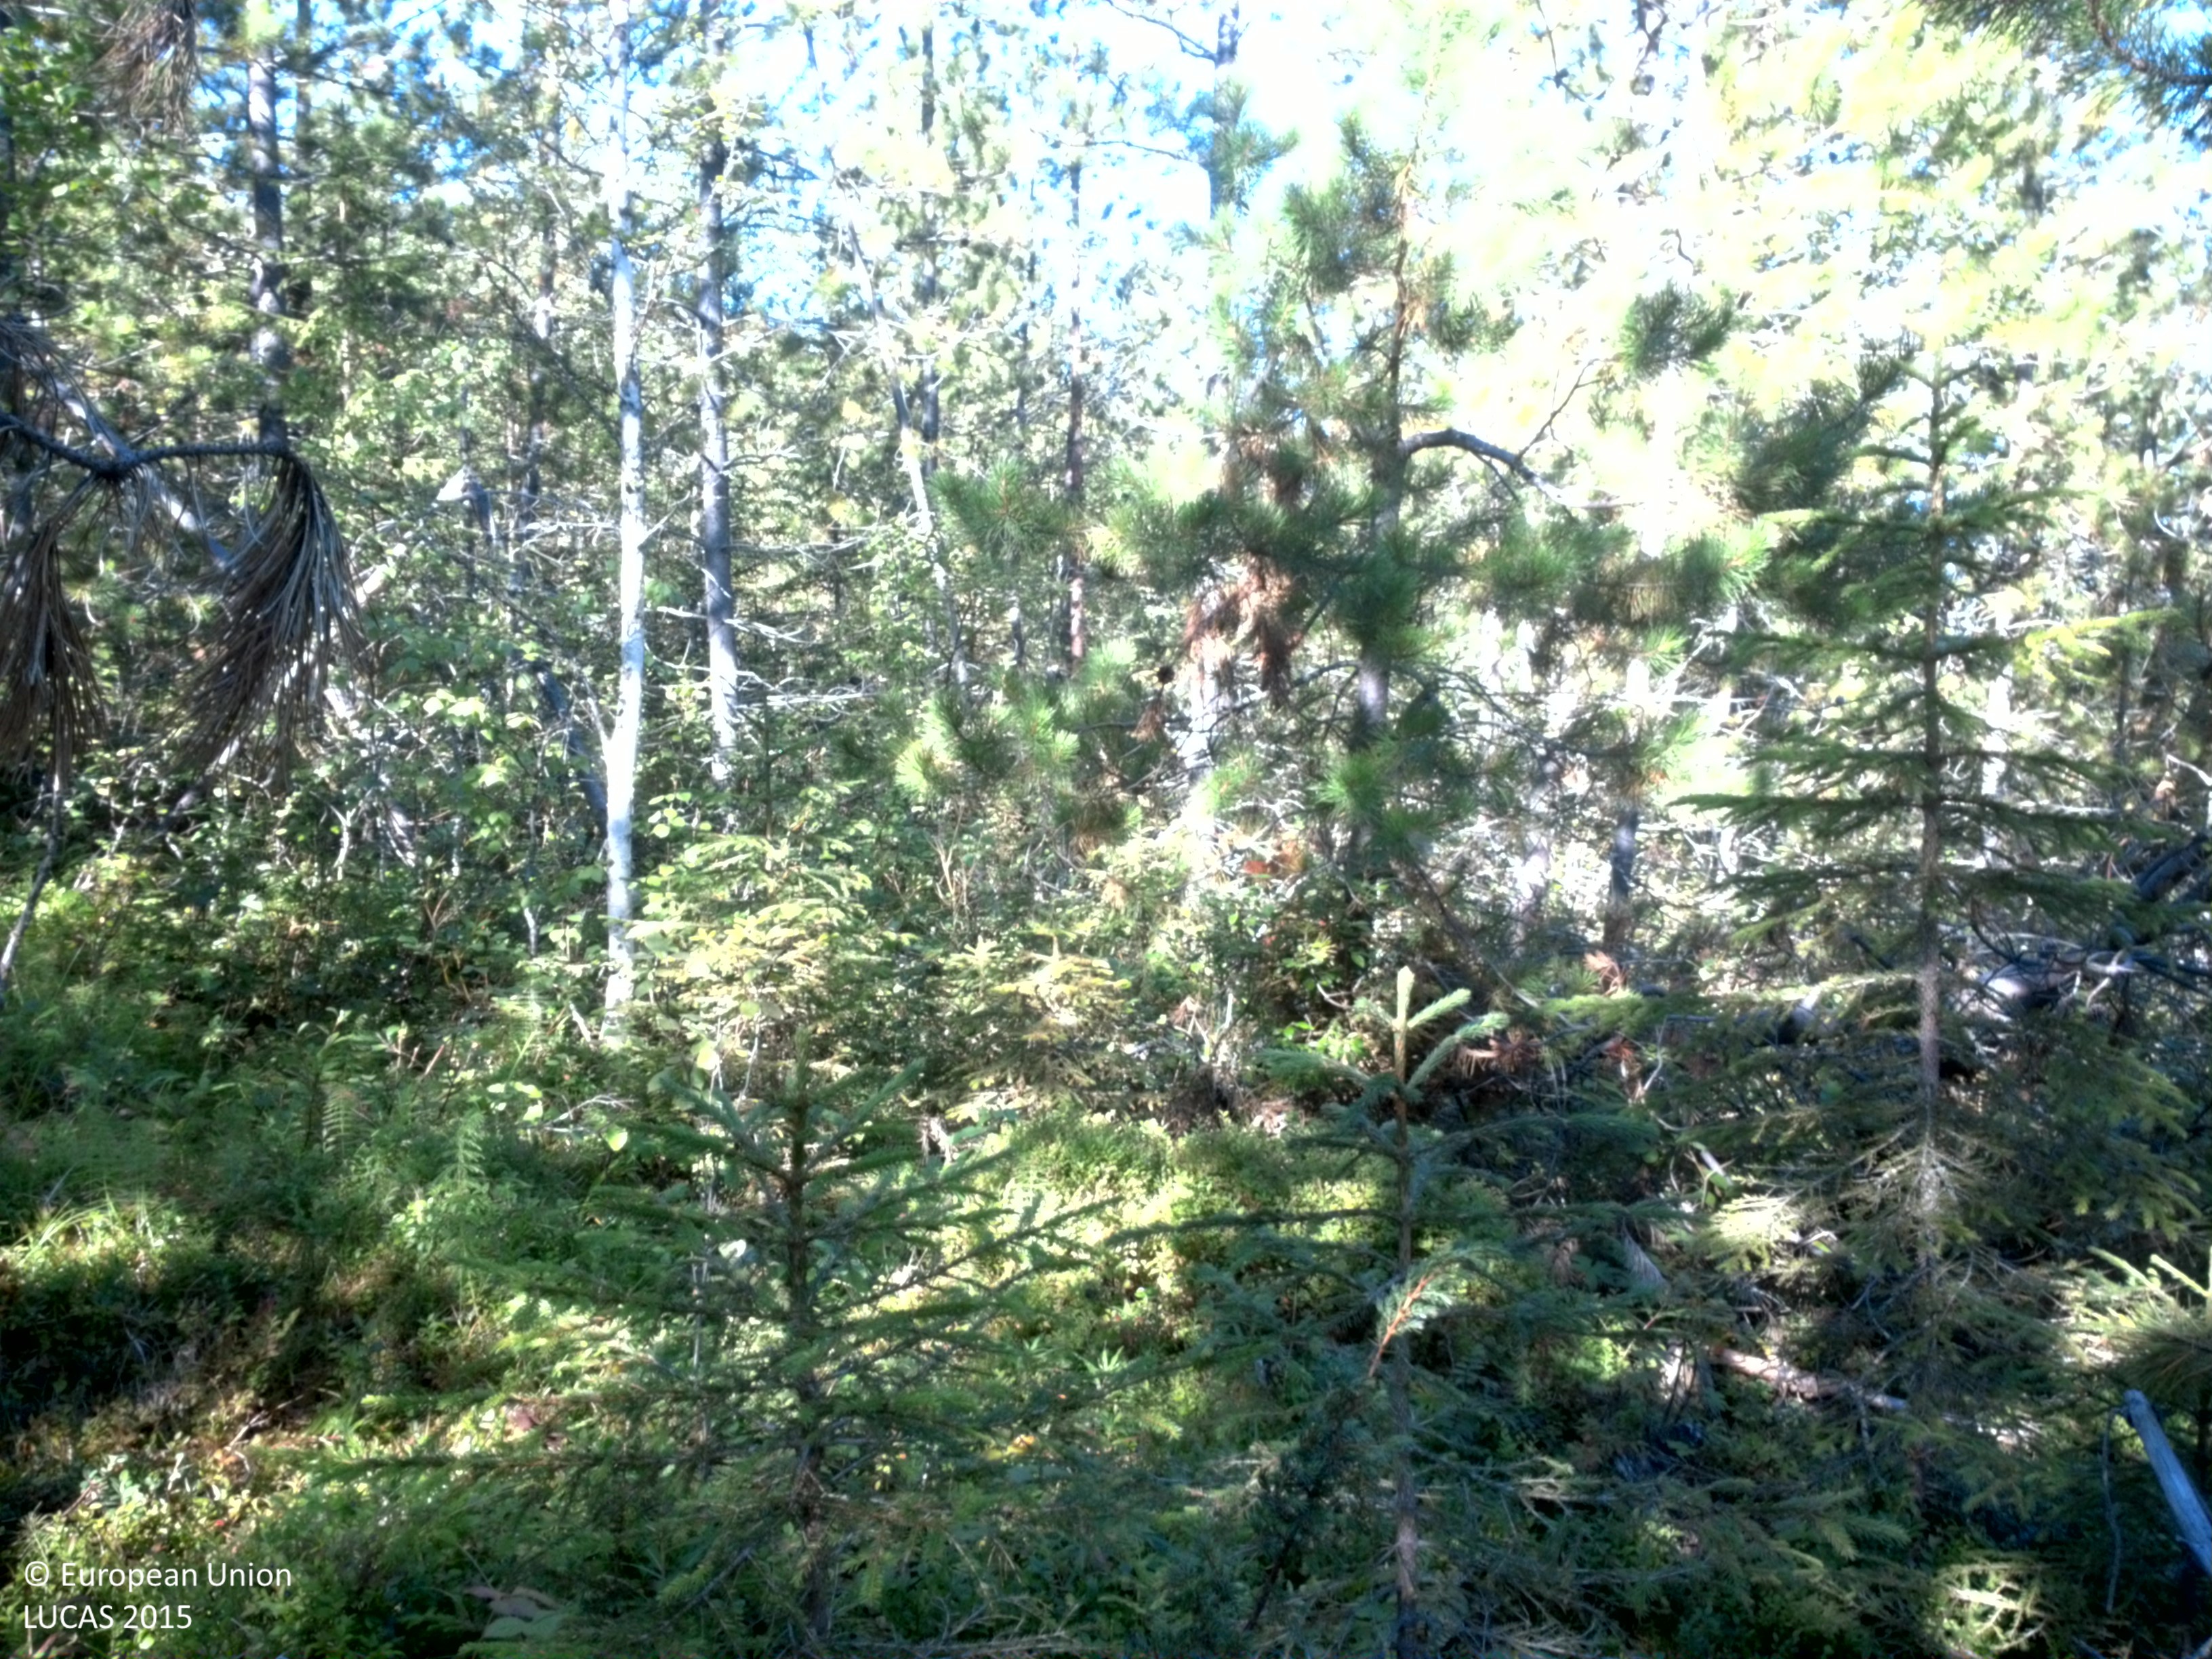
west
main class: Woodland
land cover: Pine dominated mixed woodland
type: exotic forest
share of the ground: 50 - 75 %
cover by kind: coniferous forest trees 45 %, shrubs 20 %, broadleaved forest trees 15 %, herbaceous plants 15 %, lichens and mosses 5 %
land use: Forestry
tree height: > 5 m
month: August
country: SE
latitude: 64.4648
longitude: 18.7642
